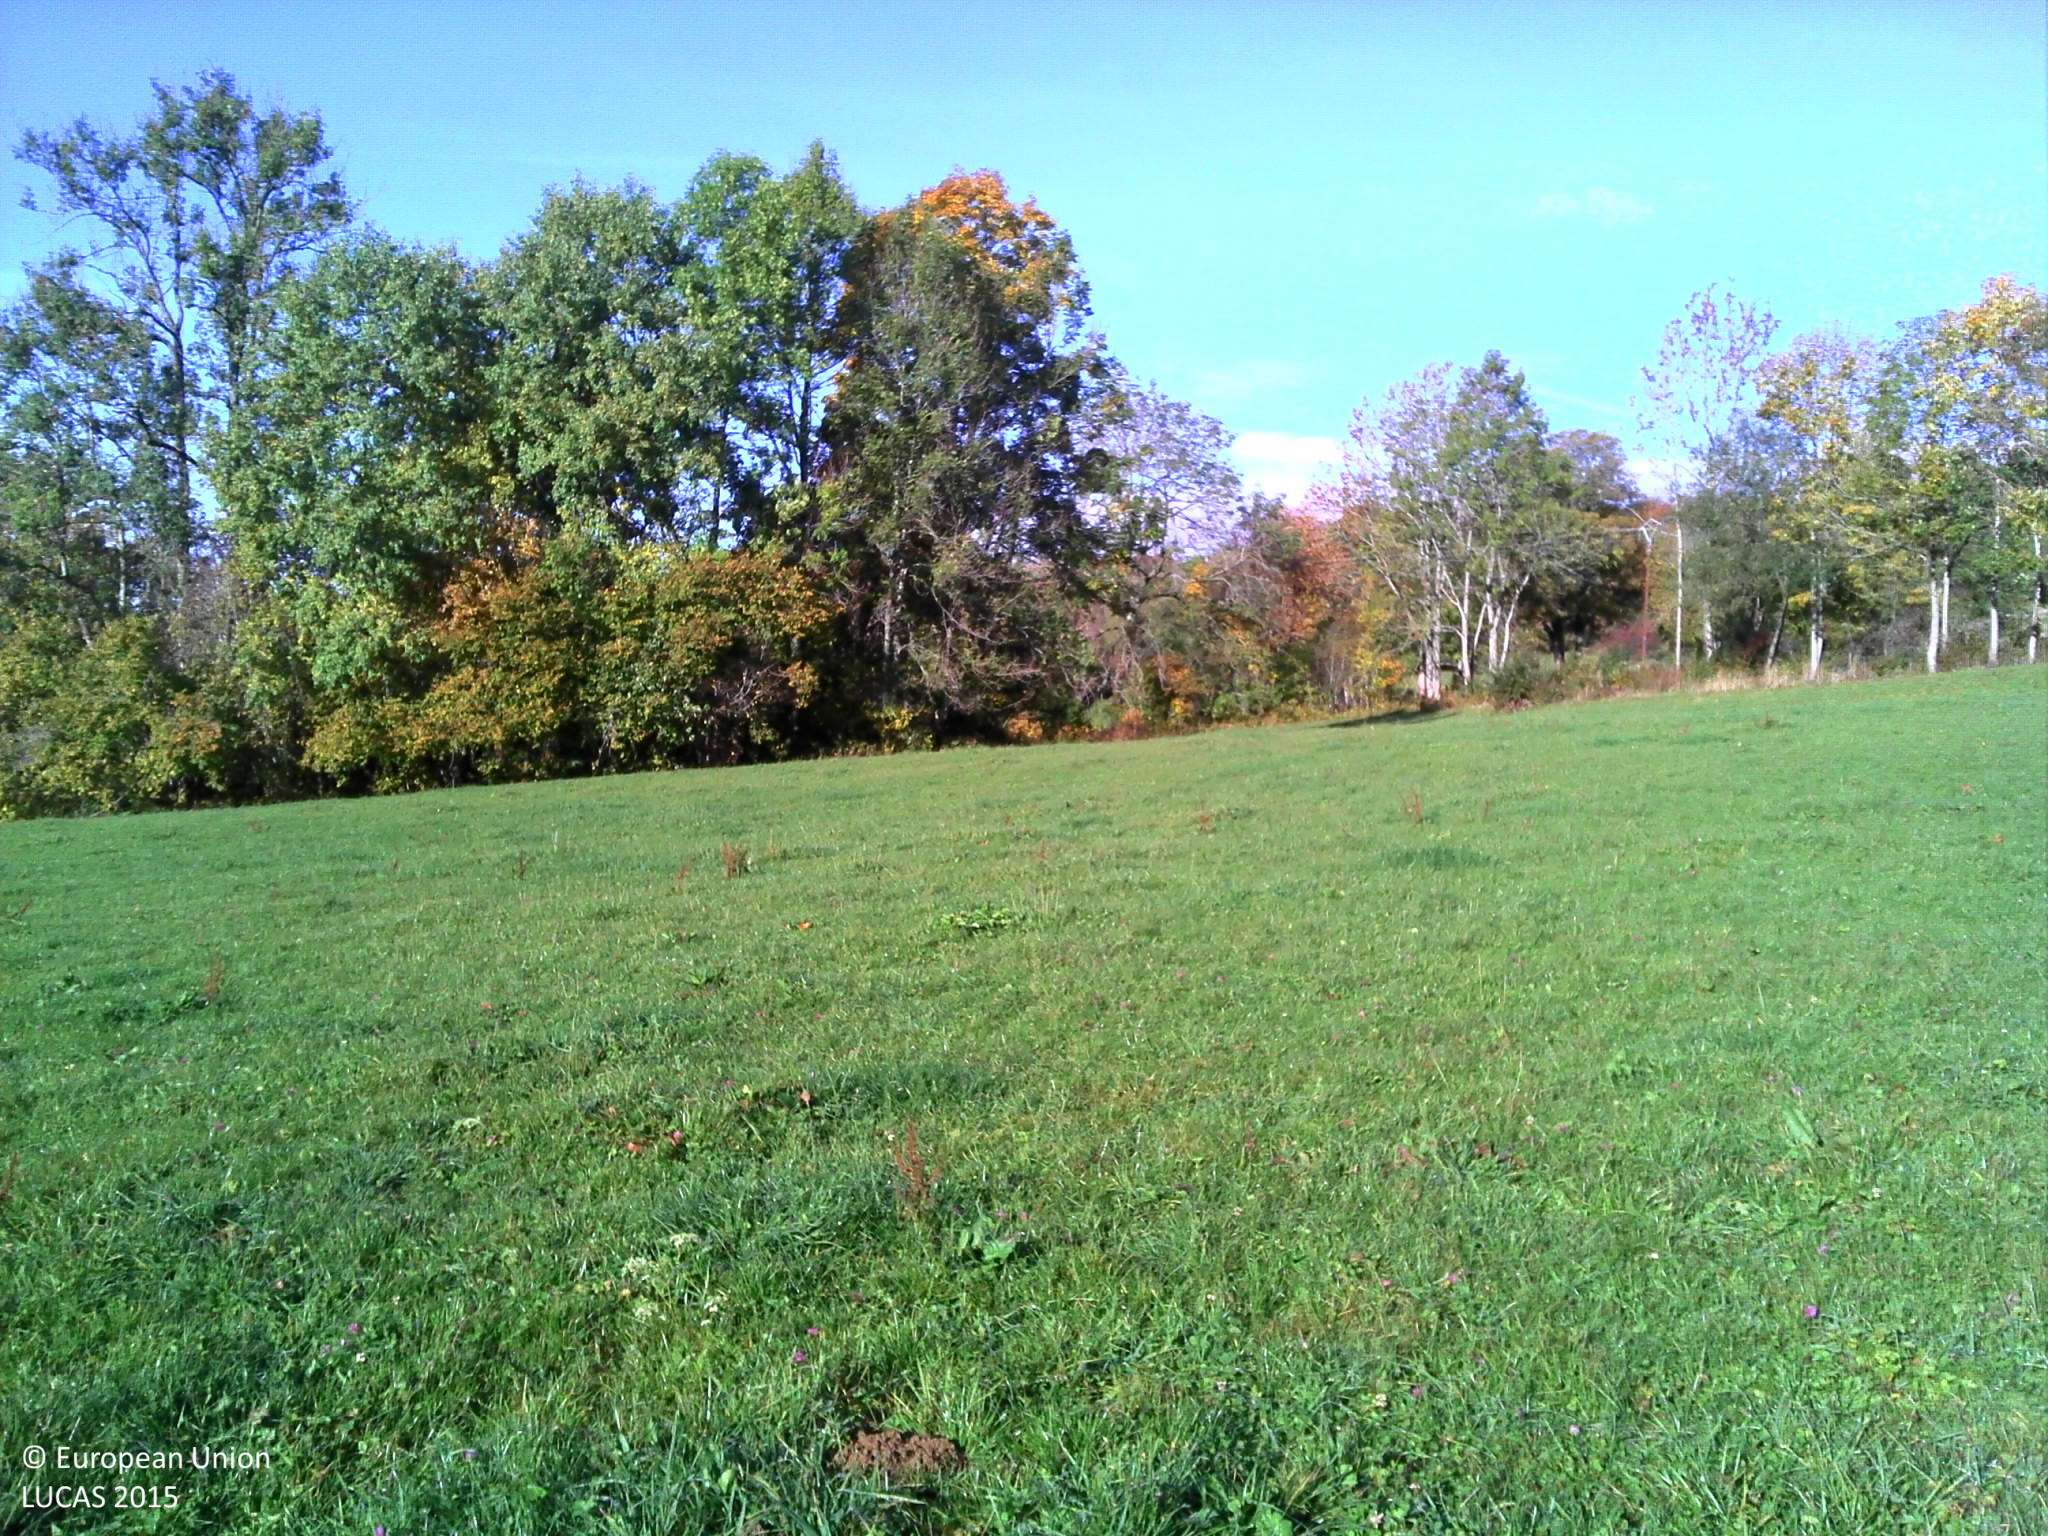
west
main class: Grassland
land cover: Grassland without tree/shrub cover
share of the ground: > 75 %
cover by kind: herbaceous plants 100 %
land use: Agriculture (excluding fallow land and kitchen gardens)
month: October
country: FR
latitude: 46.8853
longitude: 6.3936
